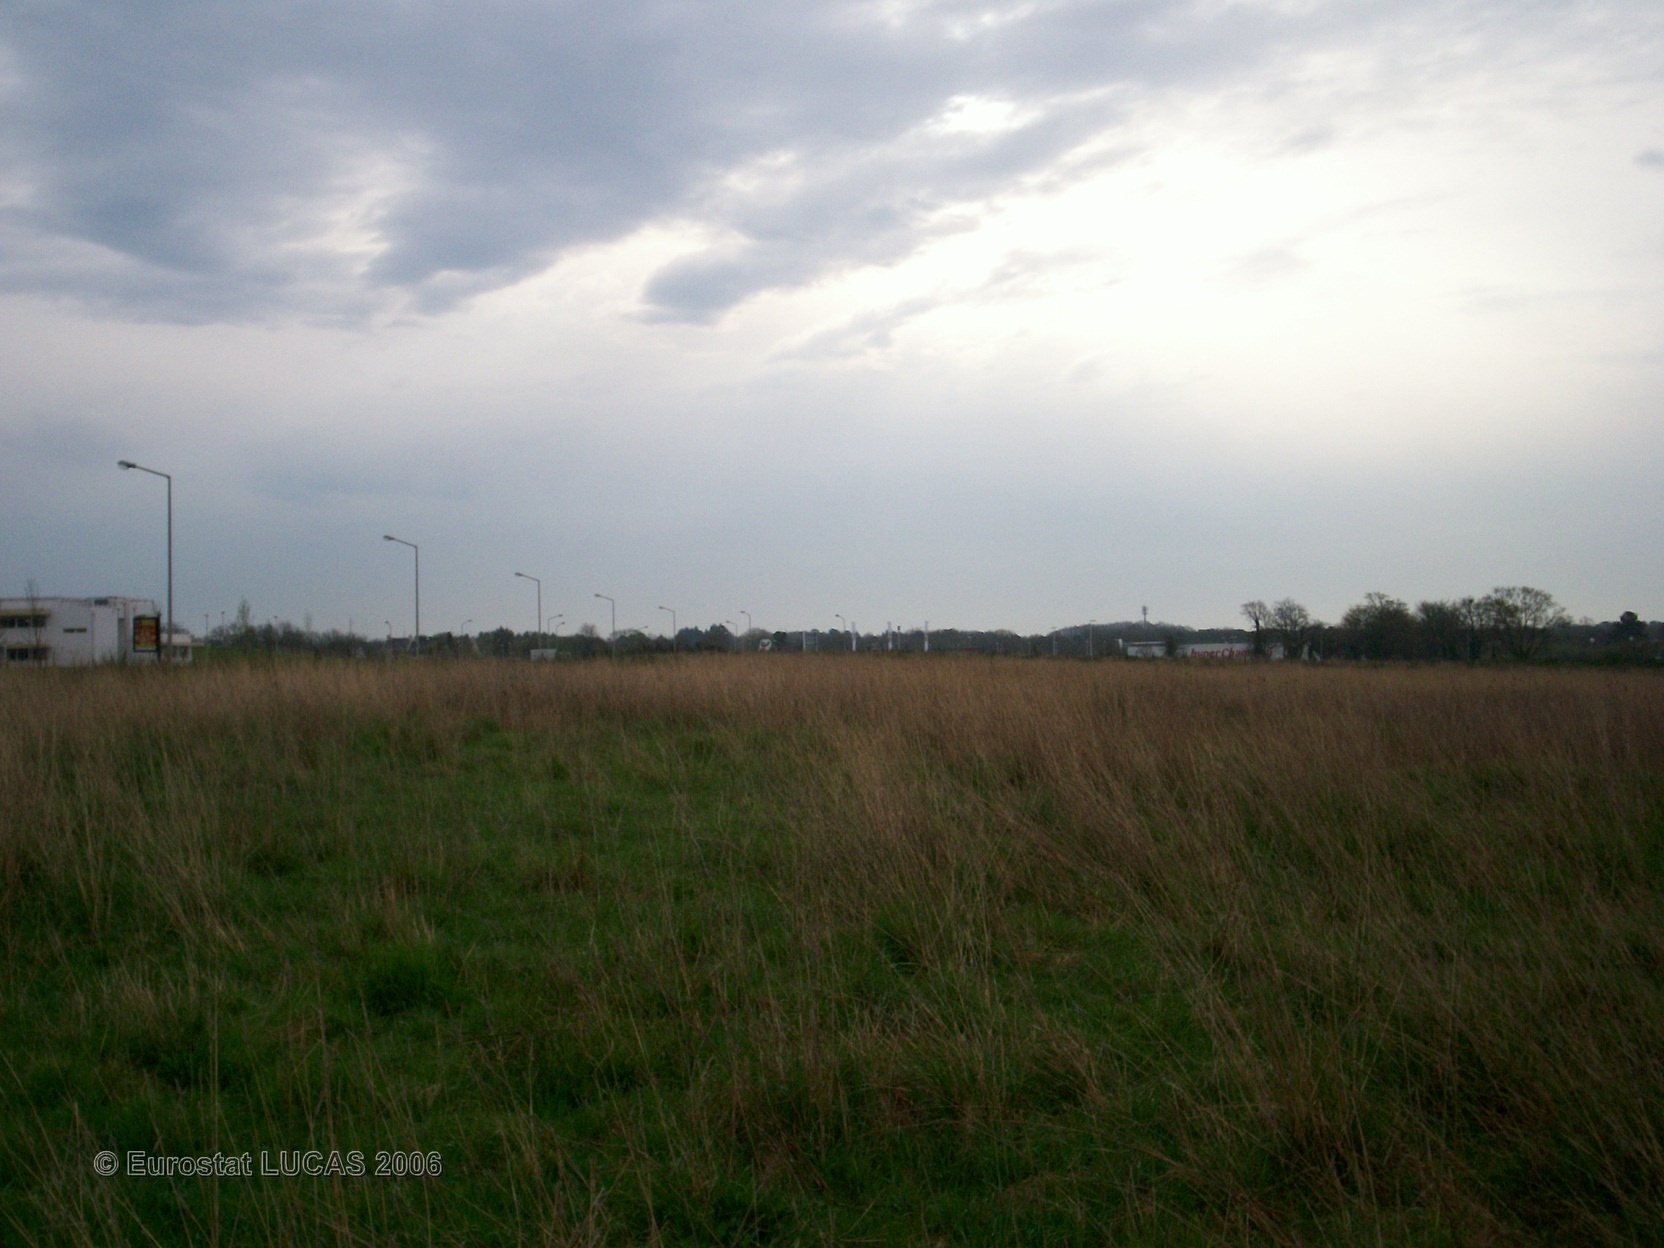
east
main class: Grassland
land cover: Grassland without tree/shrub cover
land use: Agriculture (excluding fallow land and kitchen gardens)
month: April
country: FR
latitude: 47.6438
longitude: -2.7475
